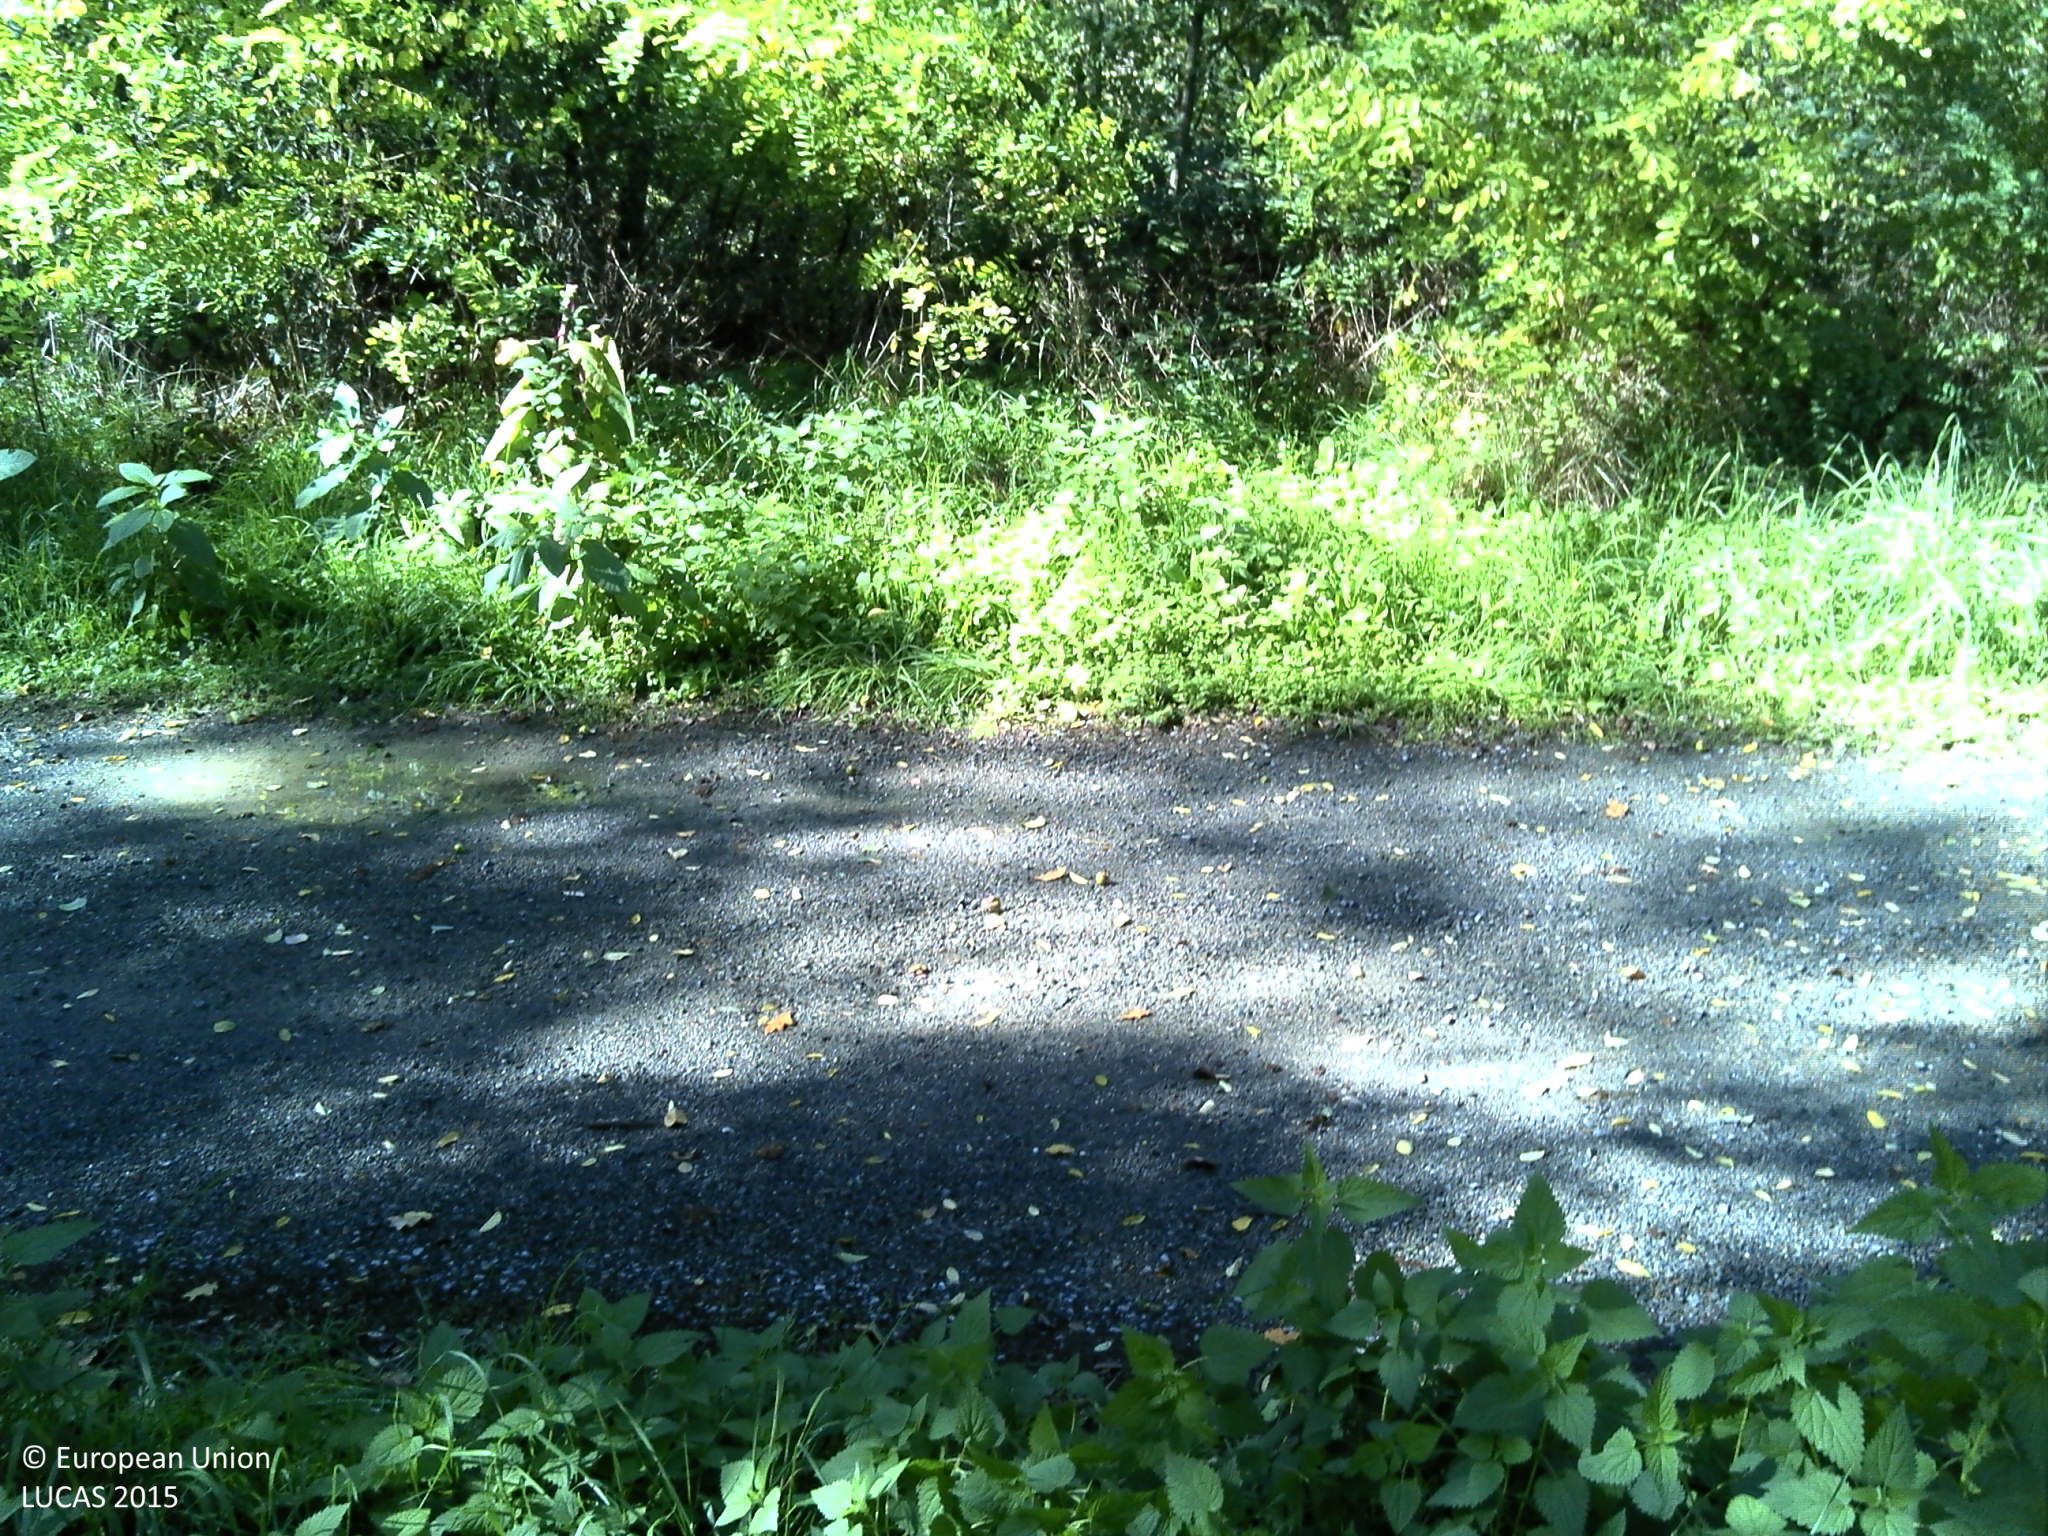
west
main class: Woodland
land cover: Broadleaved woodland
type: mesophytic deciduous forest
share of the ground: > 75 %
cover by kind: broadleaved forest trees 80 %, herbaceous plants 20 %
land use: Semi-natural and natural areas not in use
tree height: > 5 m
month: October
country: FR
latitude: 46.5835
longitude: 4.0623
